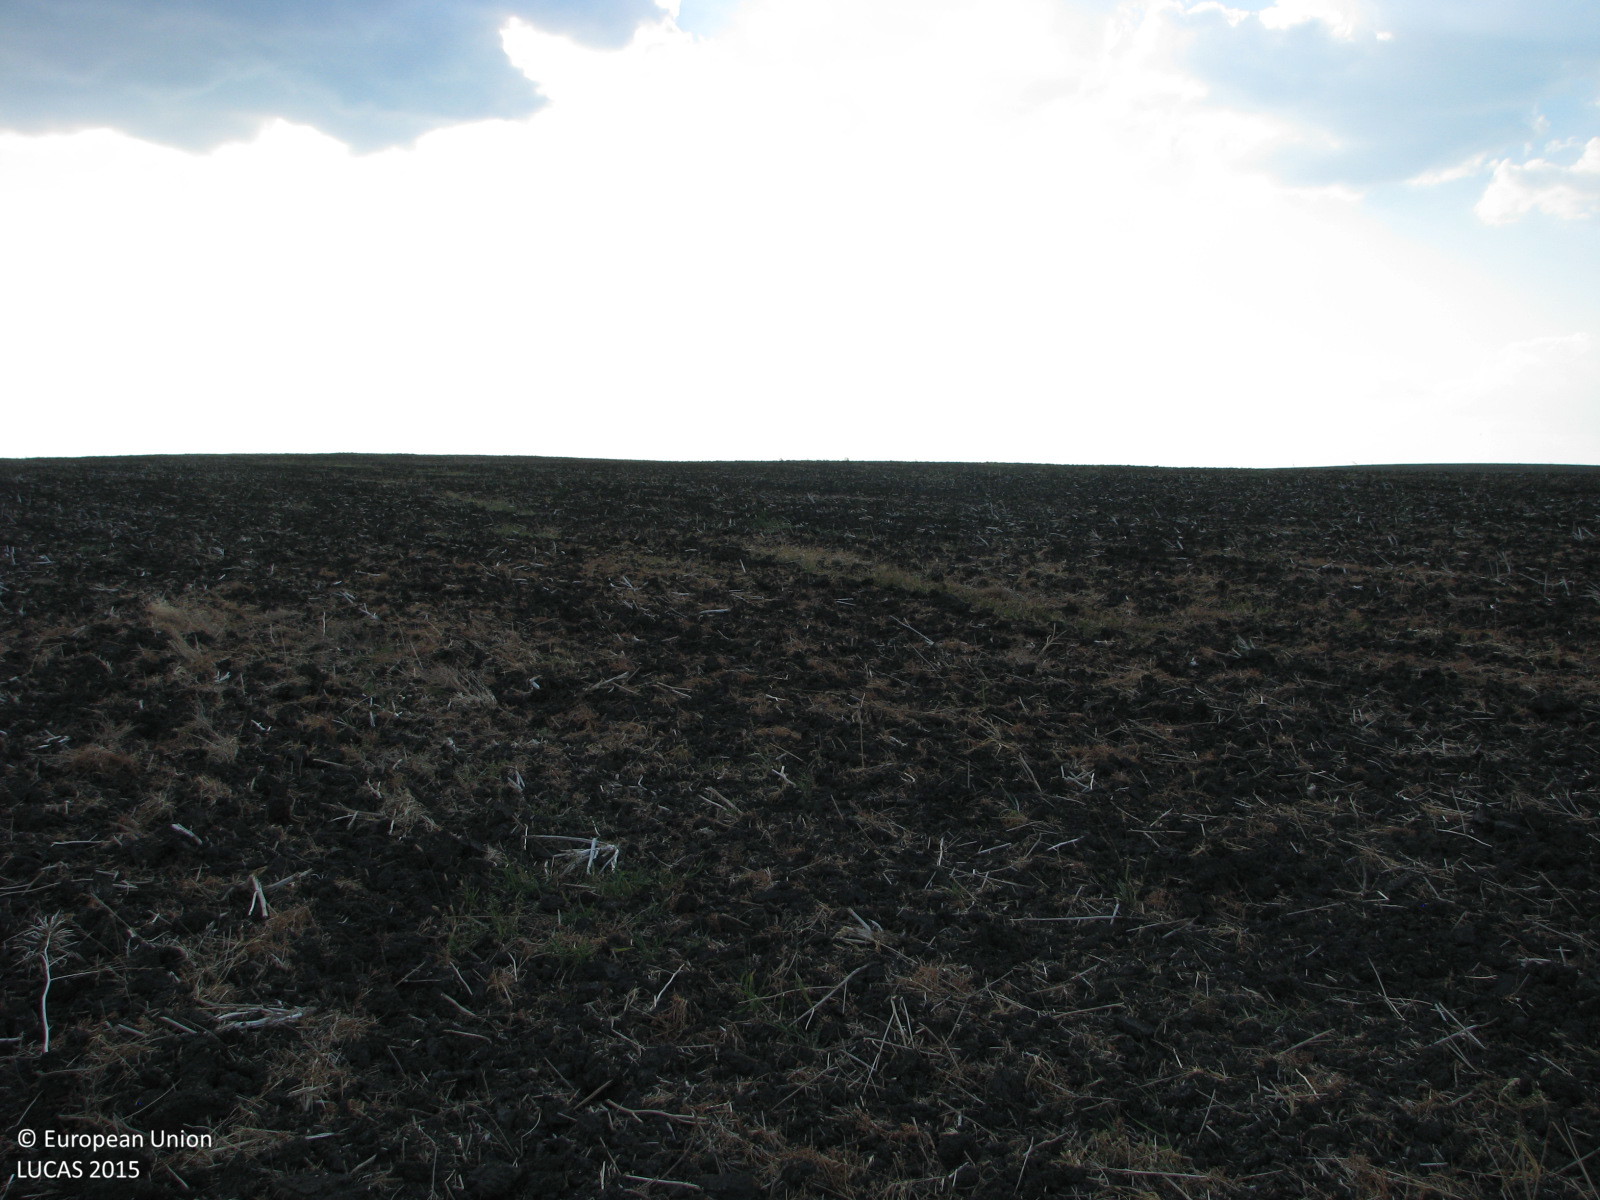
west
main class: Cropland
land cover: Other non-permanent industrial crops
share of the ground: < 10 %
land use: Agriculture (excluding fallow land and kitchen gardens)
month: August
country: BG
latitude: 42.1618
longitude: 26.7854
